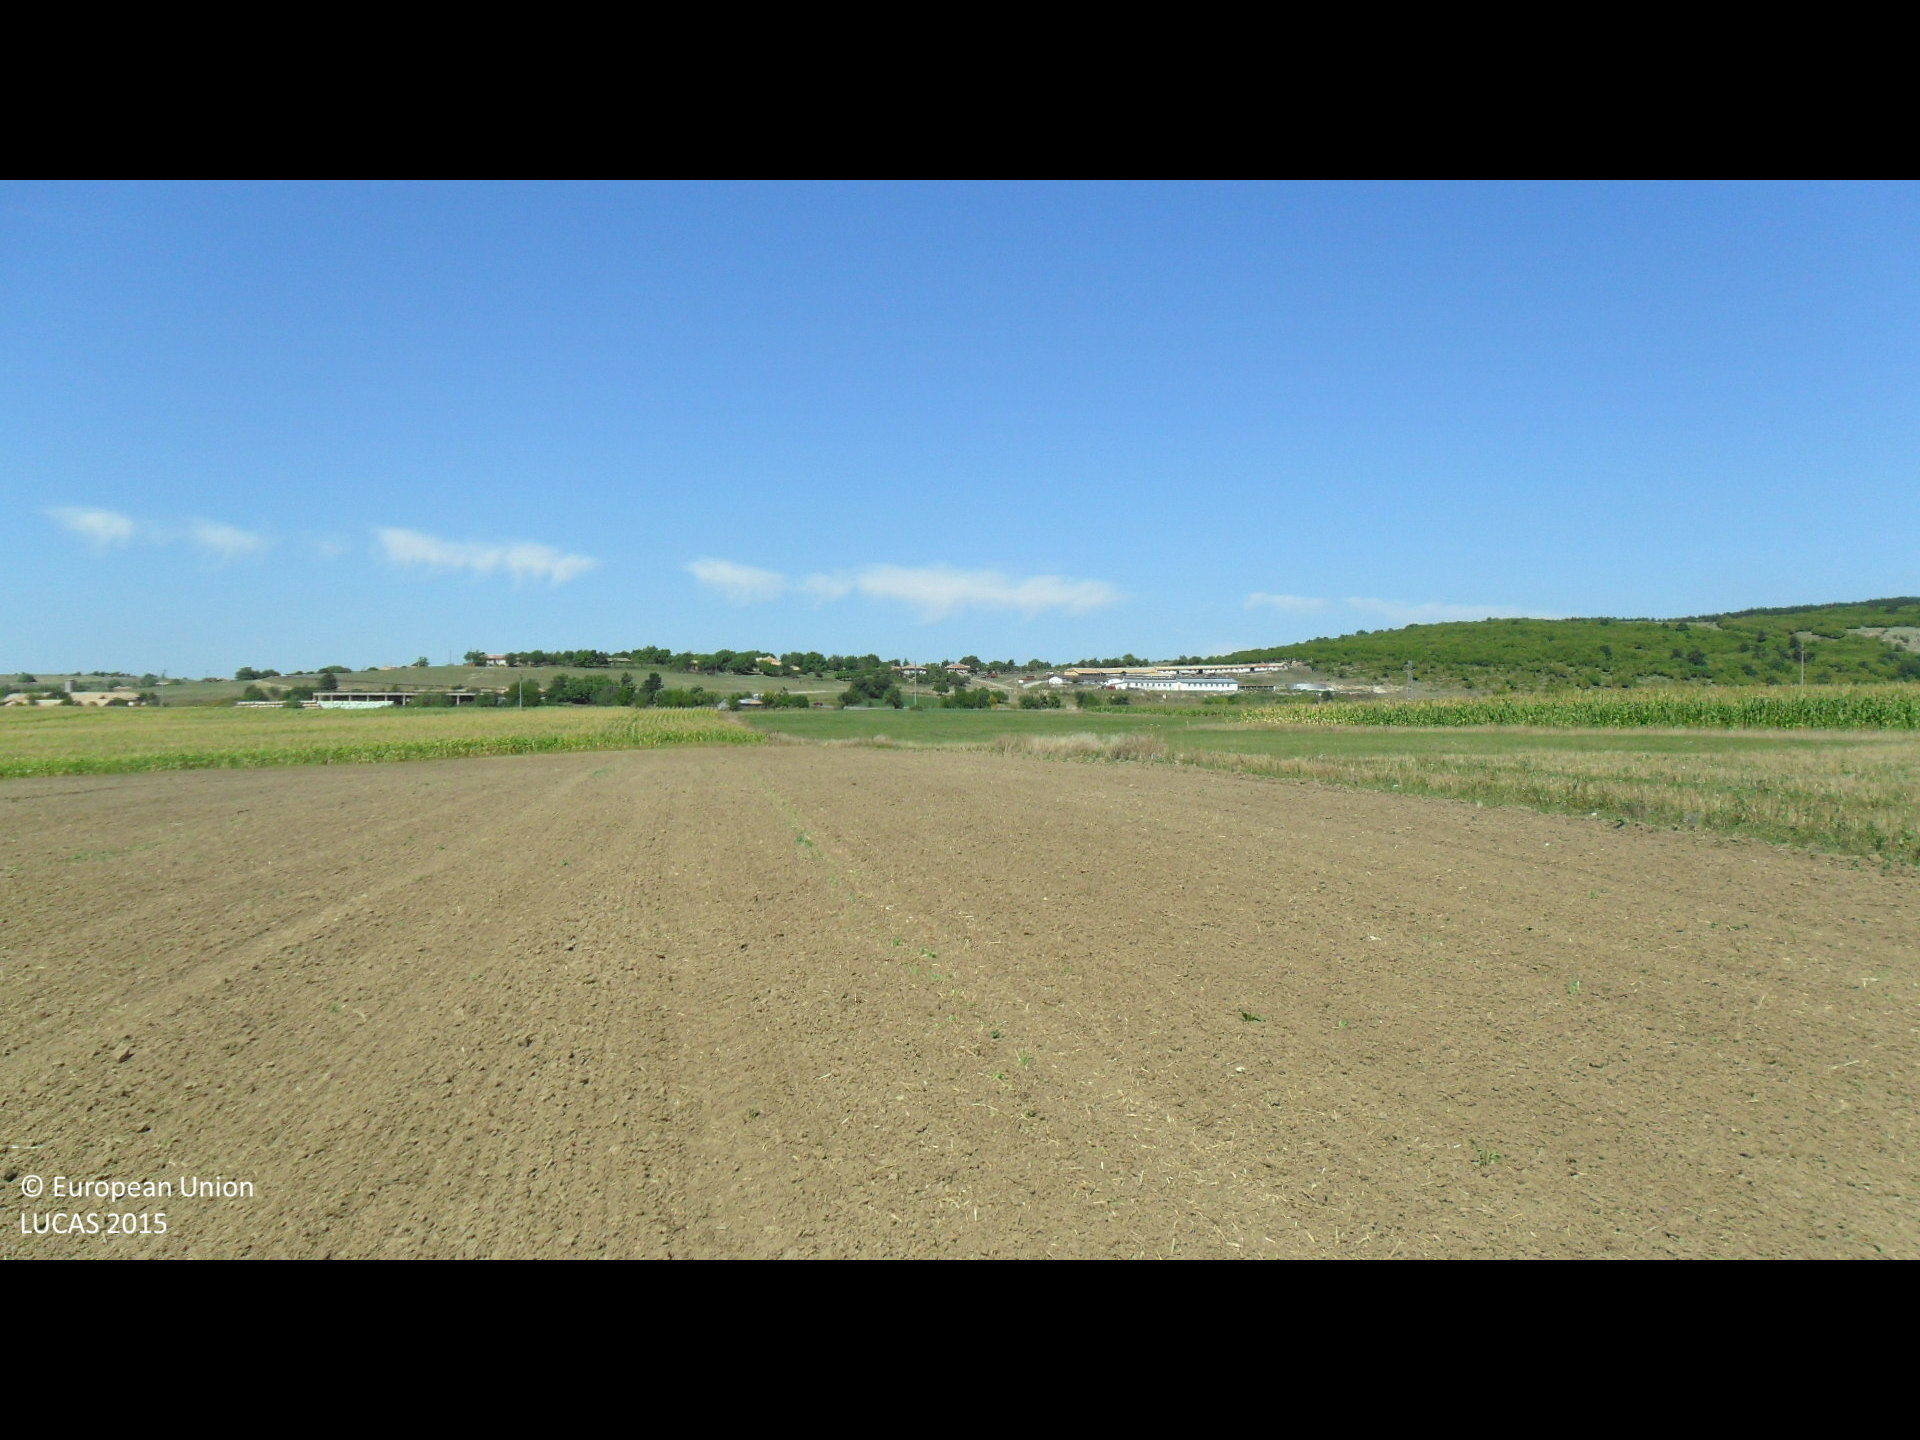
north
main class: Cropland
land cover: Common wheat
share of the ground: < 10 %
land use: Agriculture (excluding fallow land and kitchen gardens)
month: September
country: BG
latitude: 43.1741
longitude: 26.4482
